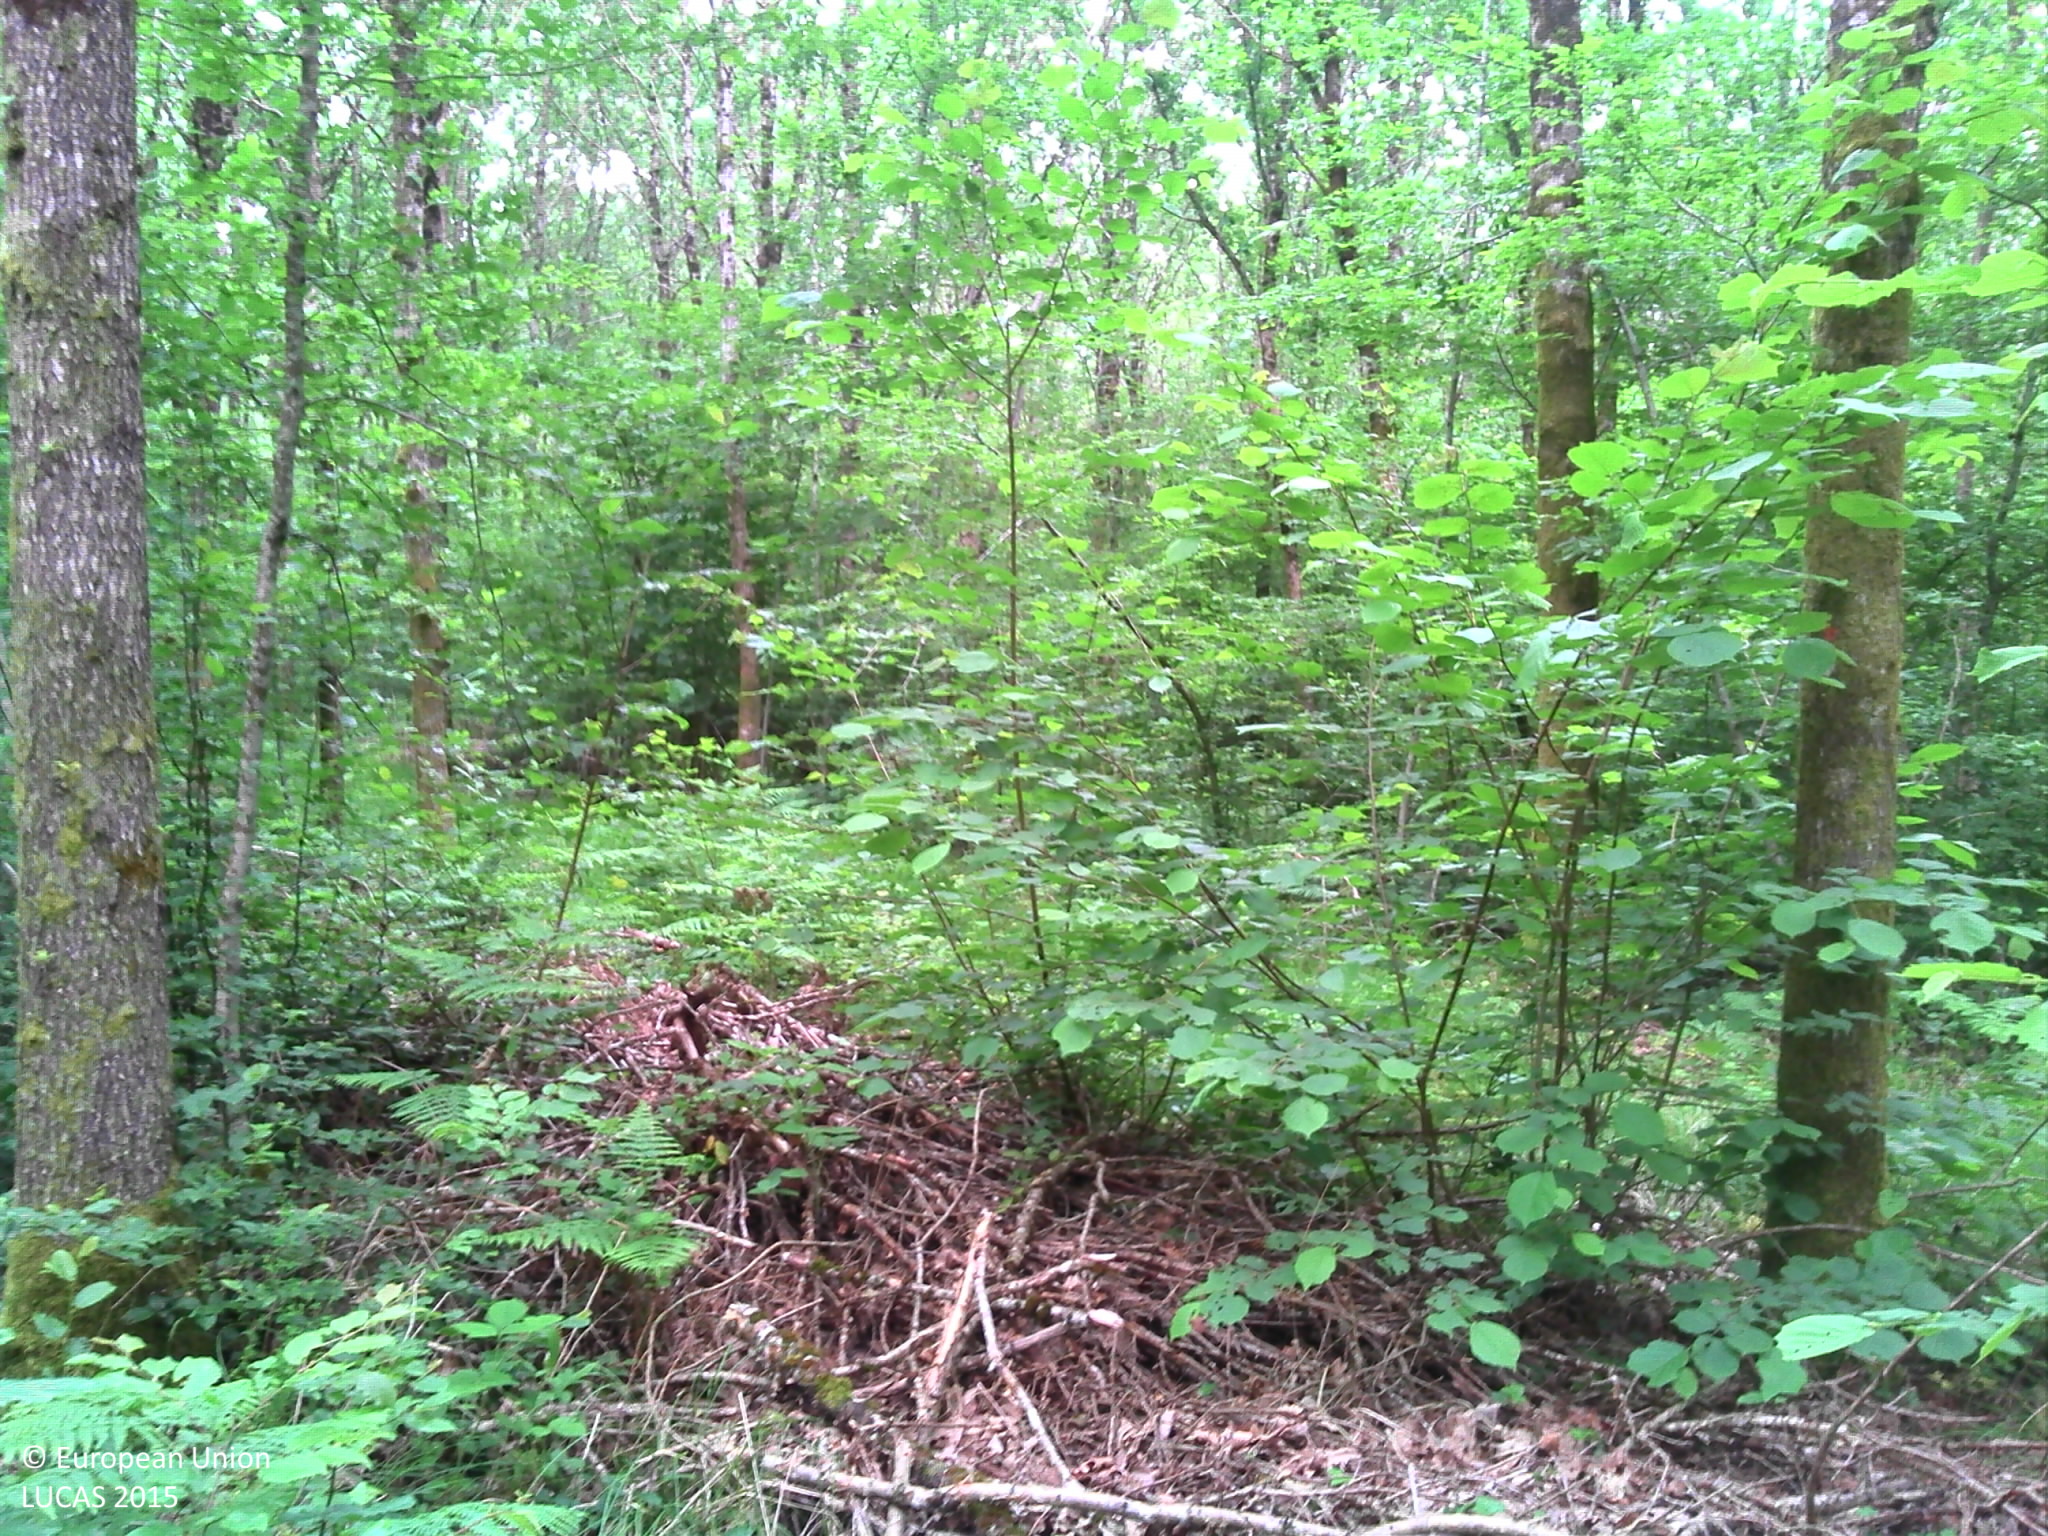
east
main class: Woodland
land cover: Broadleaved woodland
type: mesophytic deciduous forest
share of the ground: > 75 %
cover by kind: broadleaved forest trees 90 %, herbaceous plants 10 %
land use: Forestry
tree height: > 5 m
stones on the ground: < 10 %
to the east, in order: Broadleaved woodland; Ditches and canals; Grass margins; Paved roads, cycling and walking lanes; Grass margins; Ditches and canals; Broadleaved woodland; Tracks; Pine dominated coniferous woodland
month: June
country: FR
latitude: 47.8004
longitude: 6.2761
